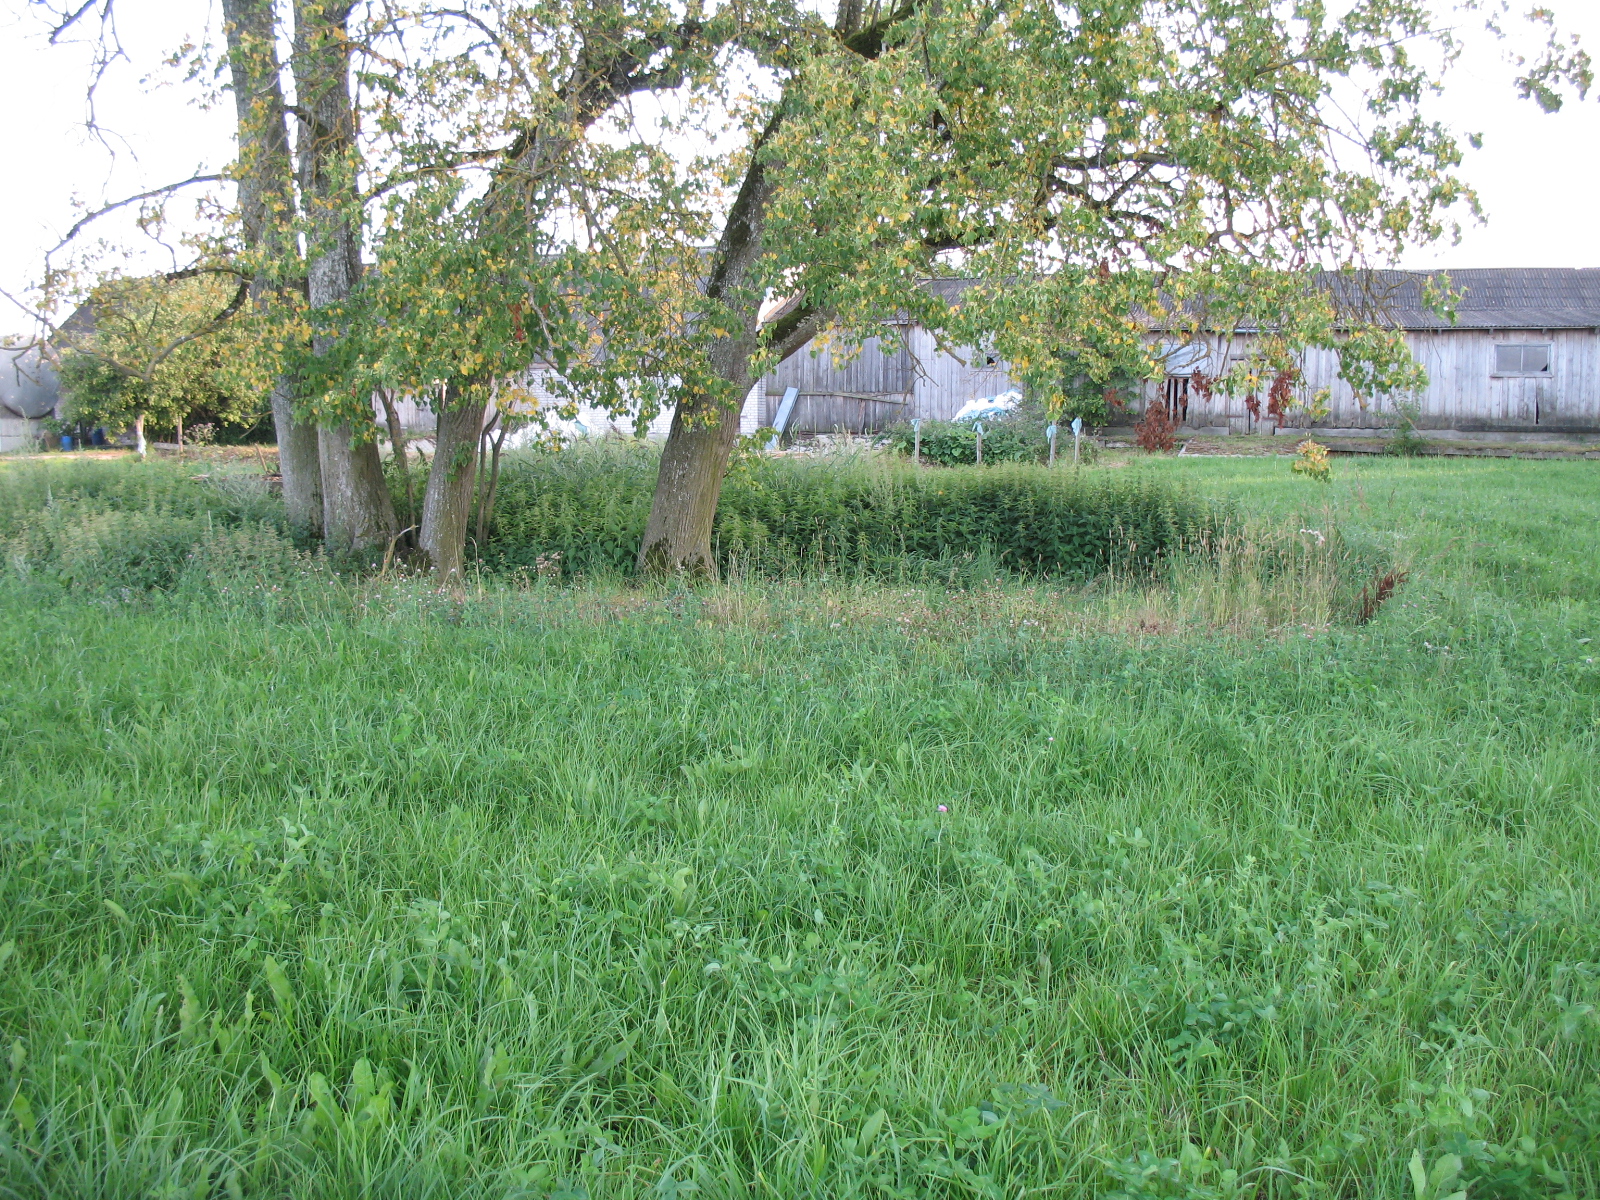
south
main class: Grassland
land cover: Grassland without tree/shrub cover
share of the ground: > 75 %
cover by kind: herbaceous plants 100 %
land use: Agriculture (excluding fallow land and kitchen gardens)
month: August
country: LV
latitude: 56.2894
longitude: 25.4518
